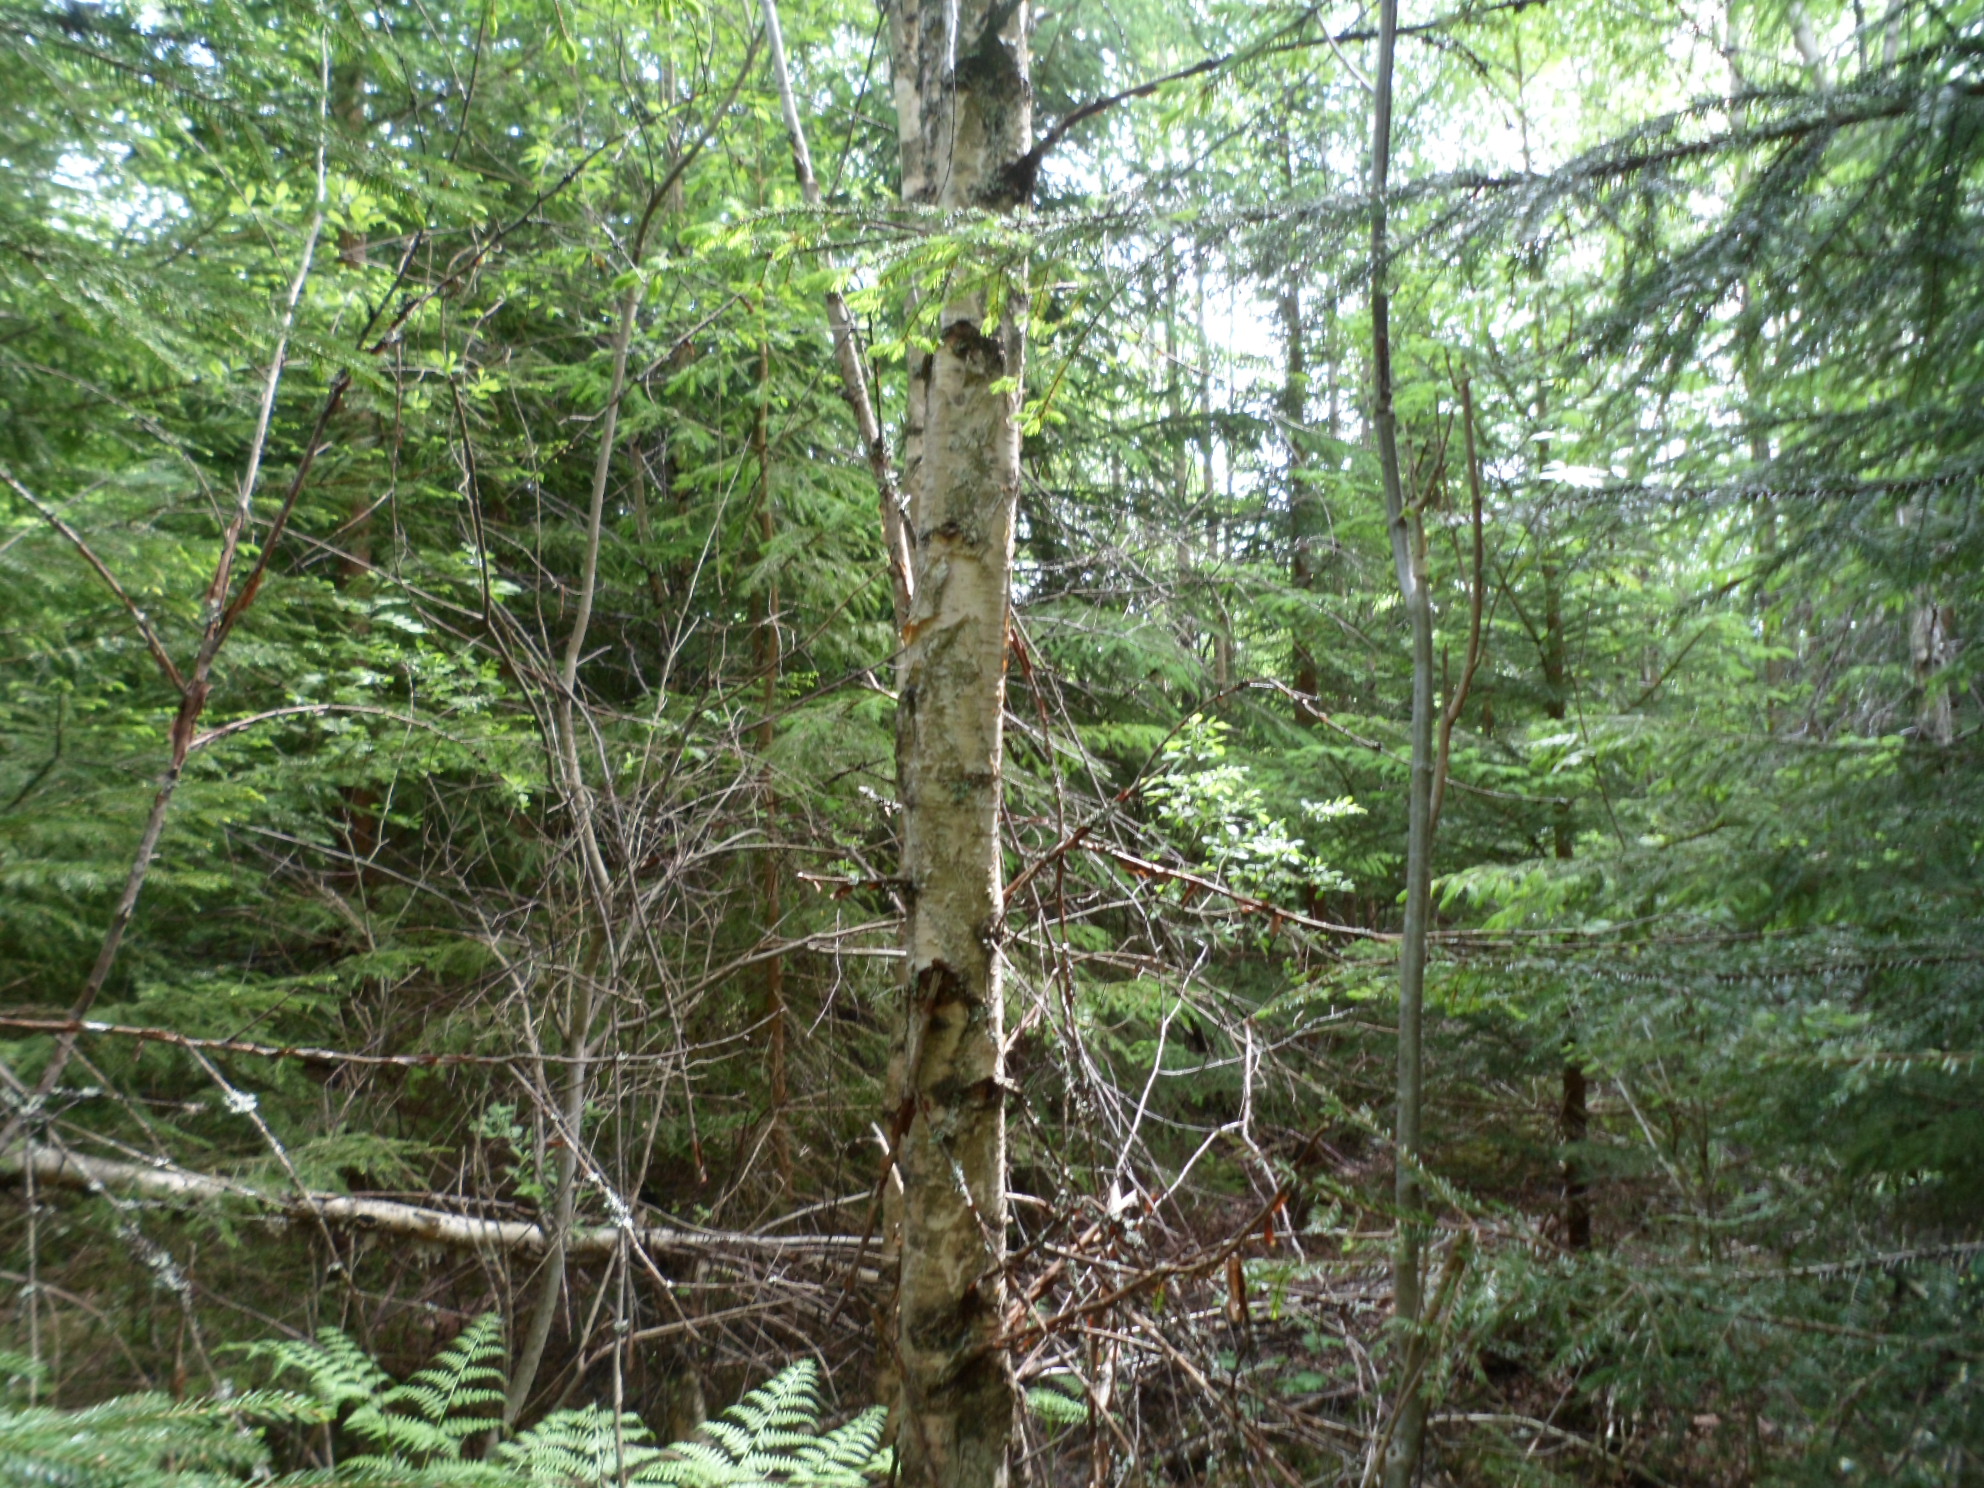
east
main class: Woodland
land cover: Spruce dominated mixed woodland
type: boreal forest
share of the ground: > 75 %
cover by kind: coniferous forest trees 40 %, broadleaved forest trees 35 %, lichens and mosses 15 %, herbaceous plants 5 %, unconsolidated bare surface 5 %
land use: Forestry
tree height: > 5 m
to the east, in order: Spruce dominated mixed woodland; Ditches and canals; Paved roads, cycling and walking lanes; Ditches and canals; Electric lines; Spruce dominated mixed woodland; Tracks; Spruce dominated mixed woodland; Grassland with sparse tree/shrub cover; Spruce dominated mixed woodland
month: June
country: SE
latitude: 56.9789
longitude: 15.3121
